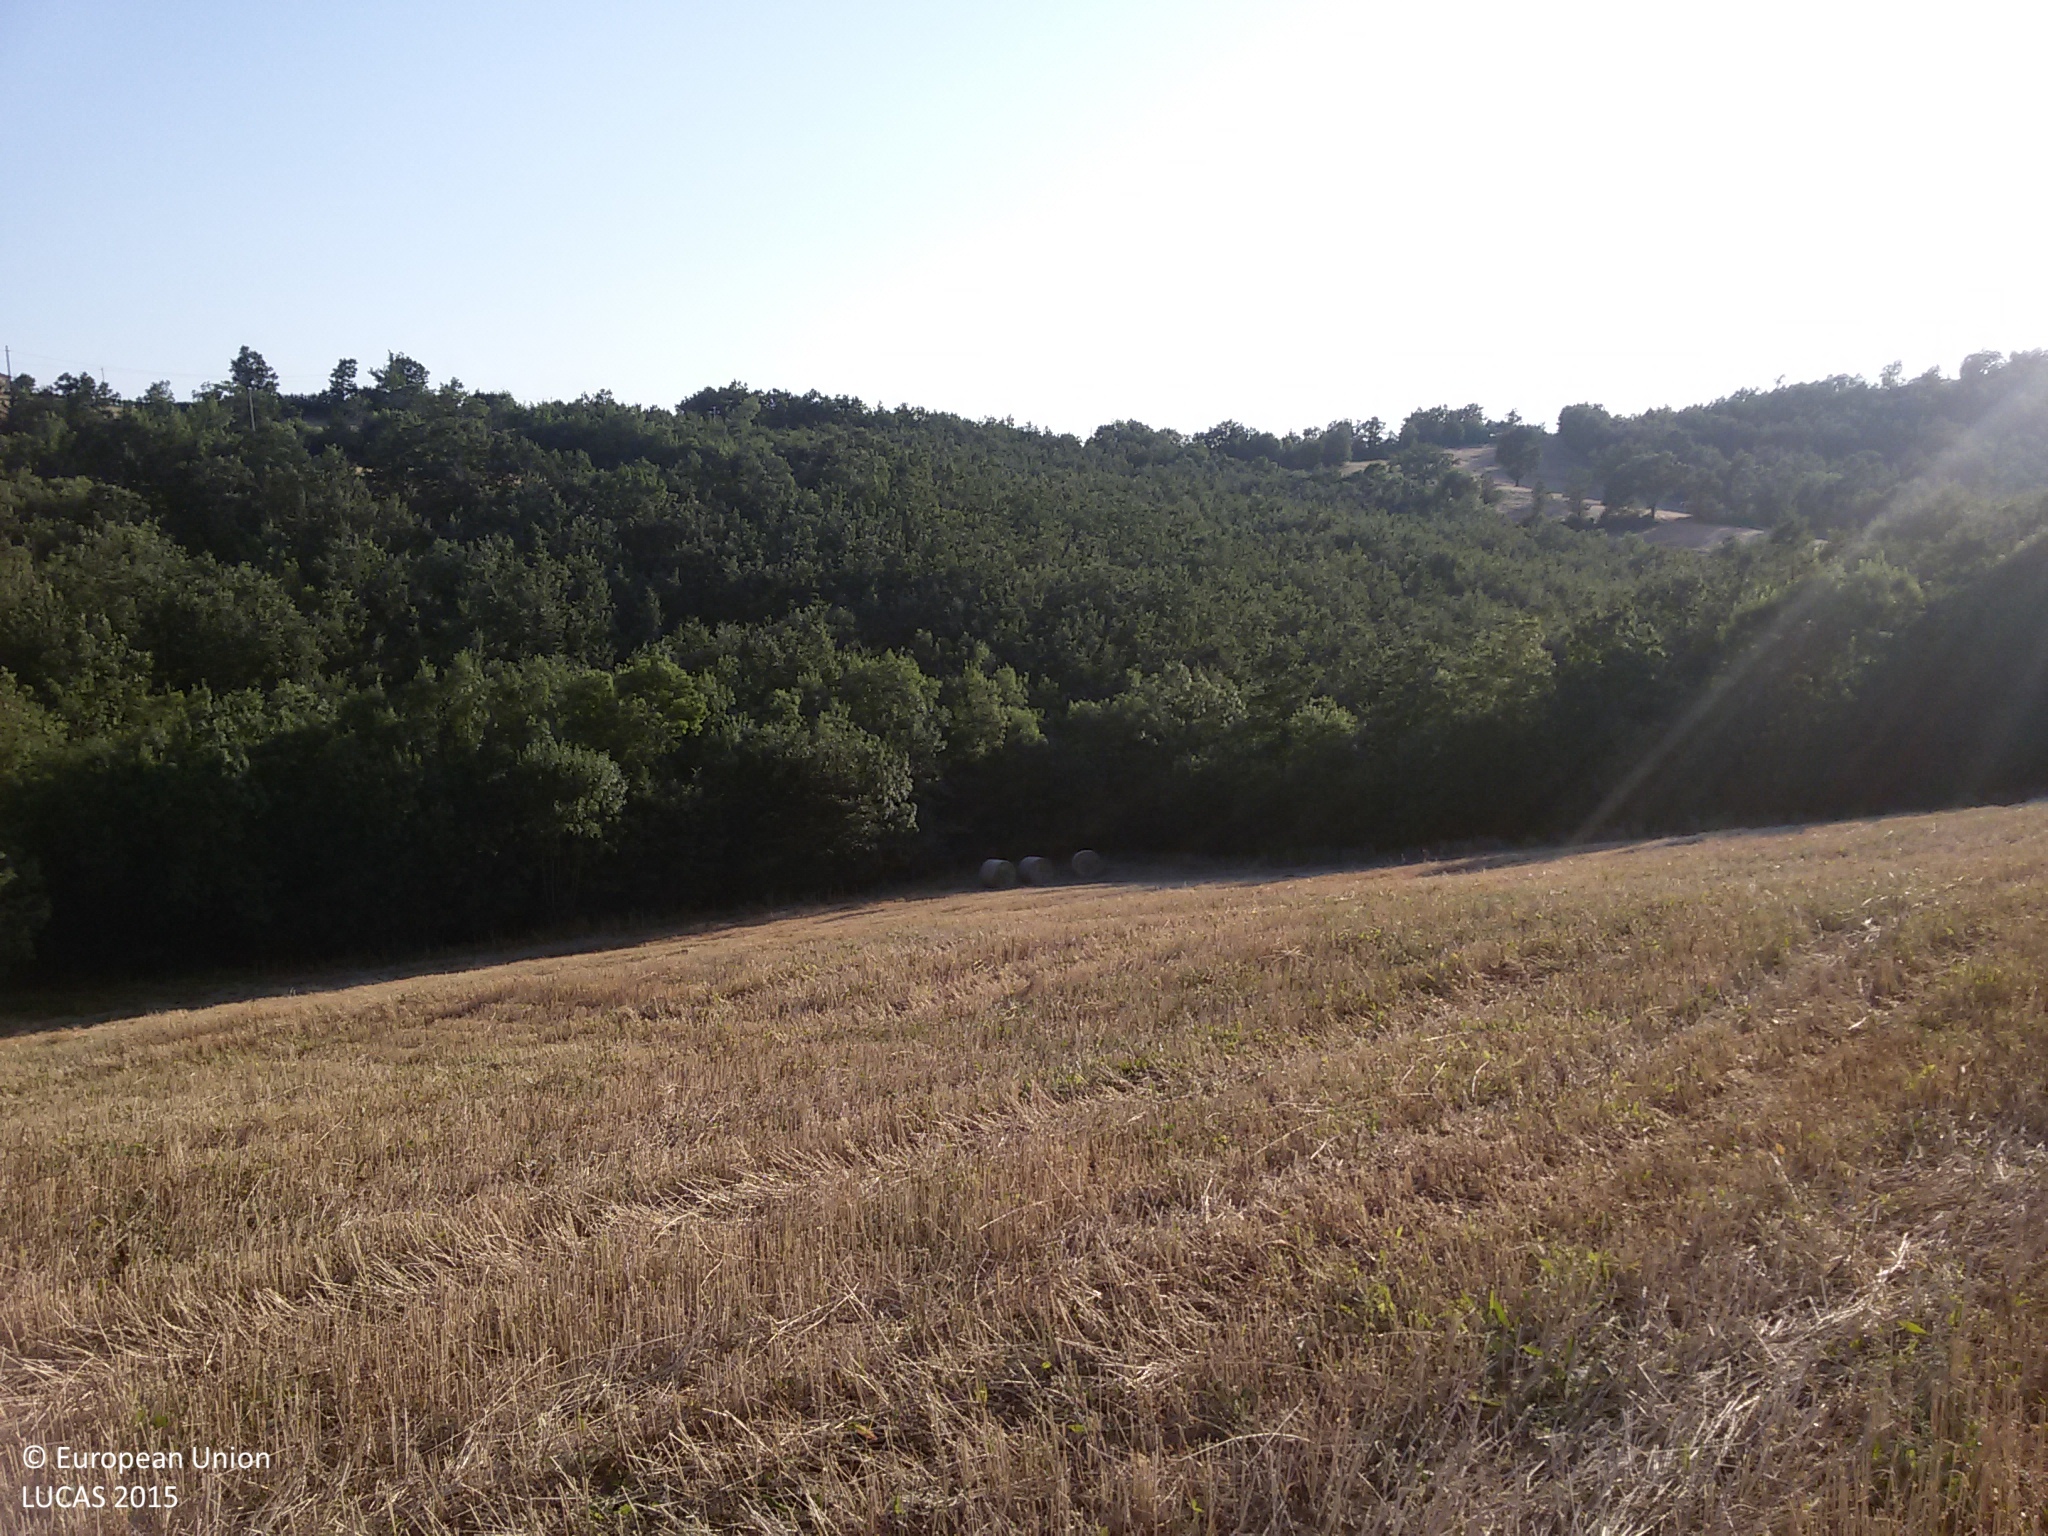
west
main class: Cropland
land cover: Durum wheat
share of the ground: > 75 %
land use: Agriculture (excluding fallow land and kitchen gardens)
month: July
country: IT
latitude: 42.7517
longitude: 11.4735
